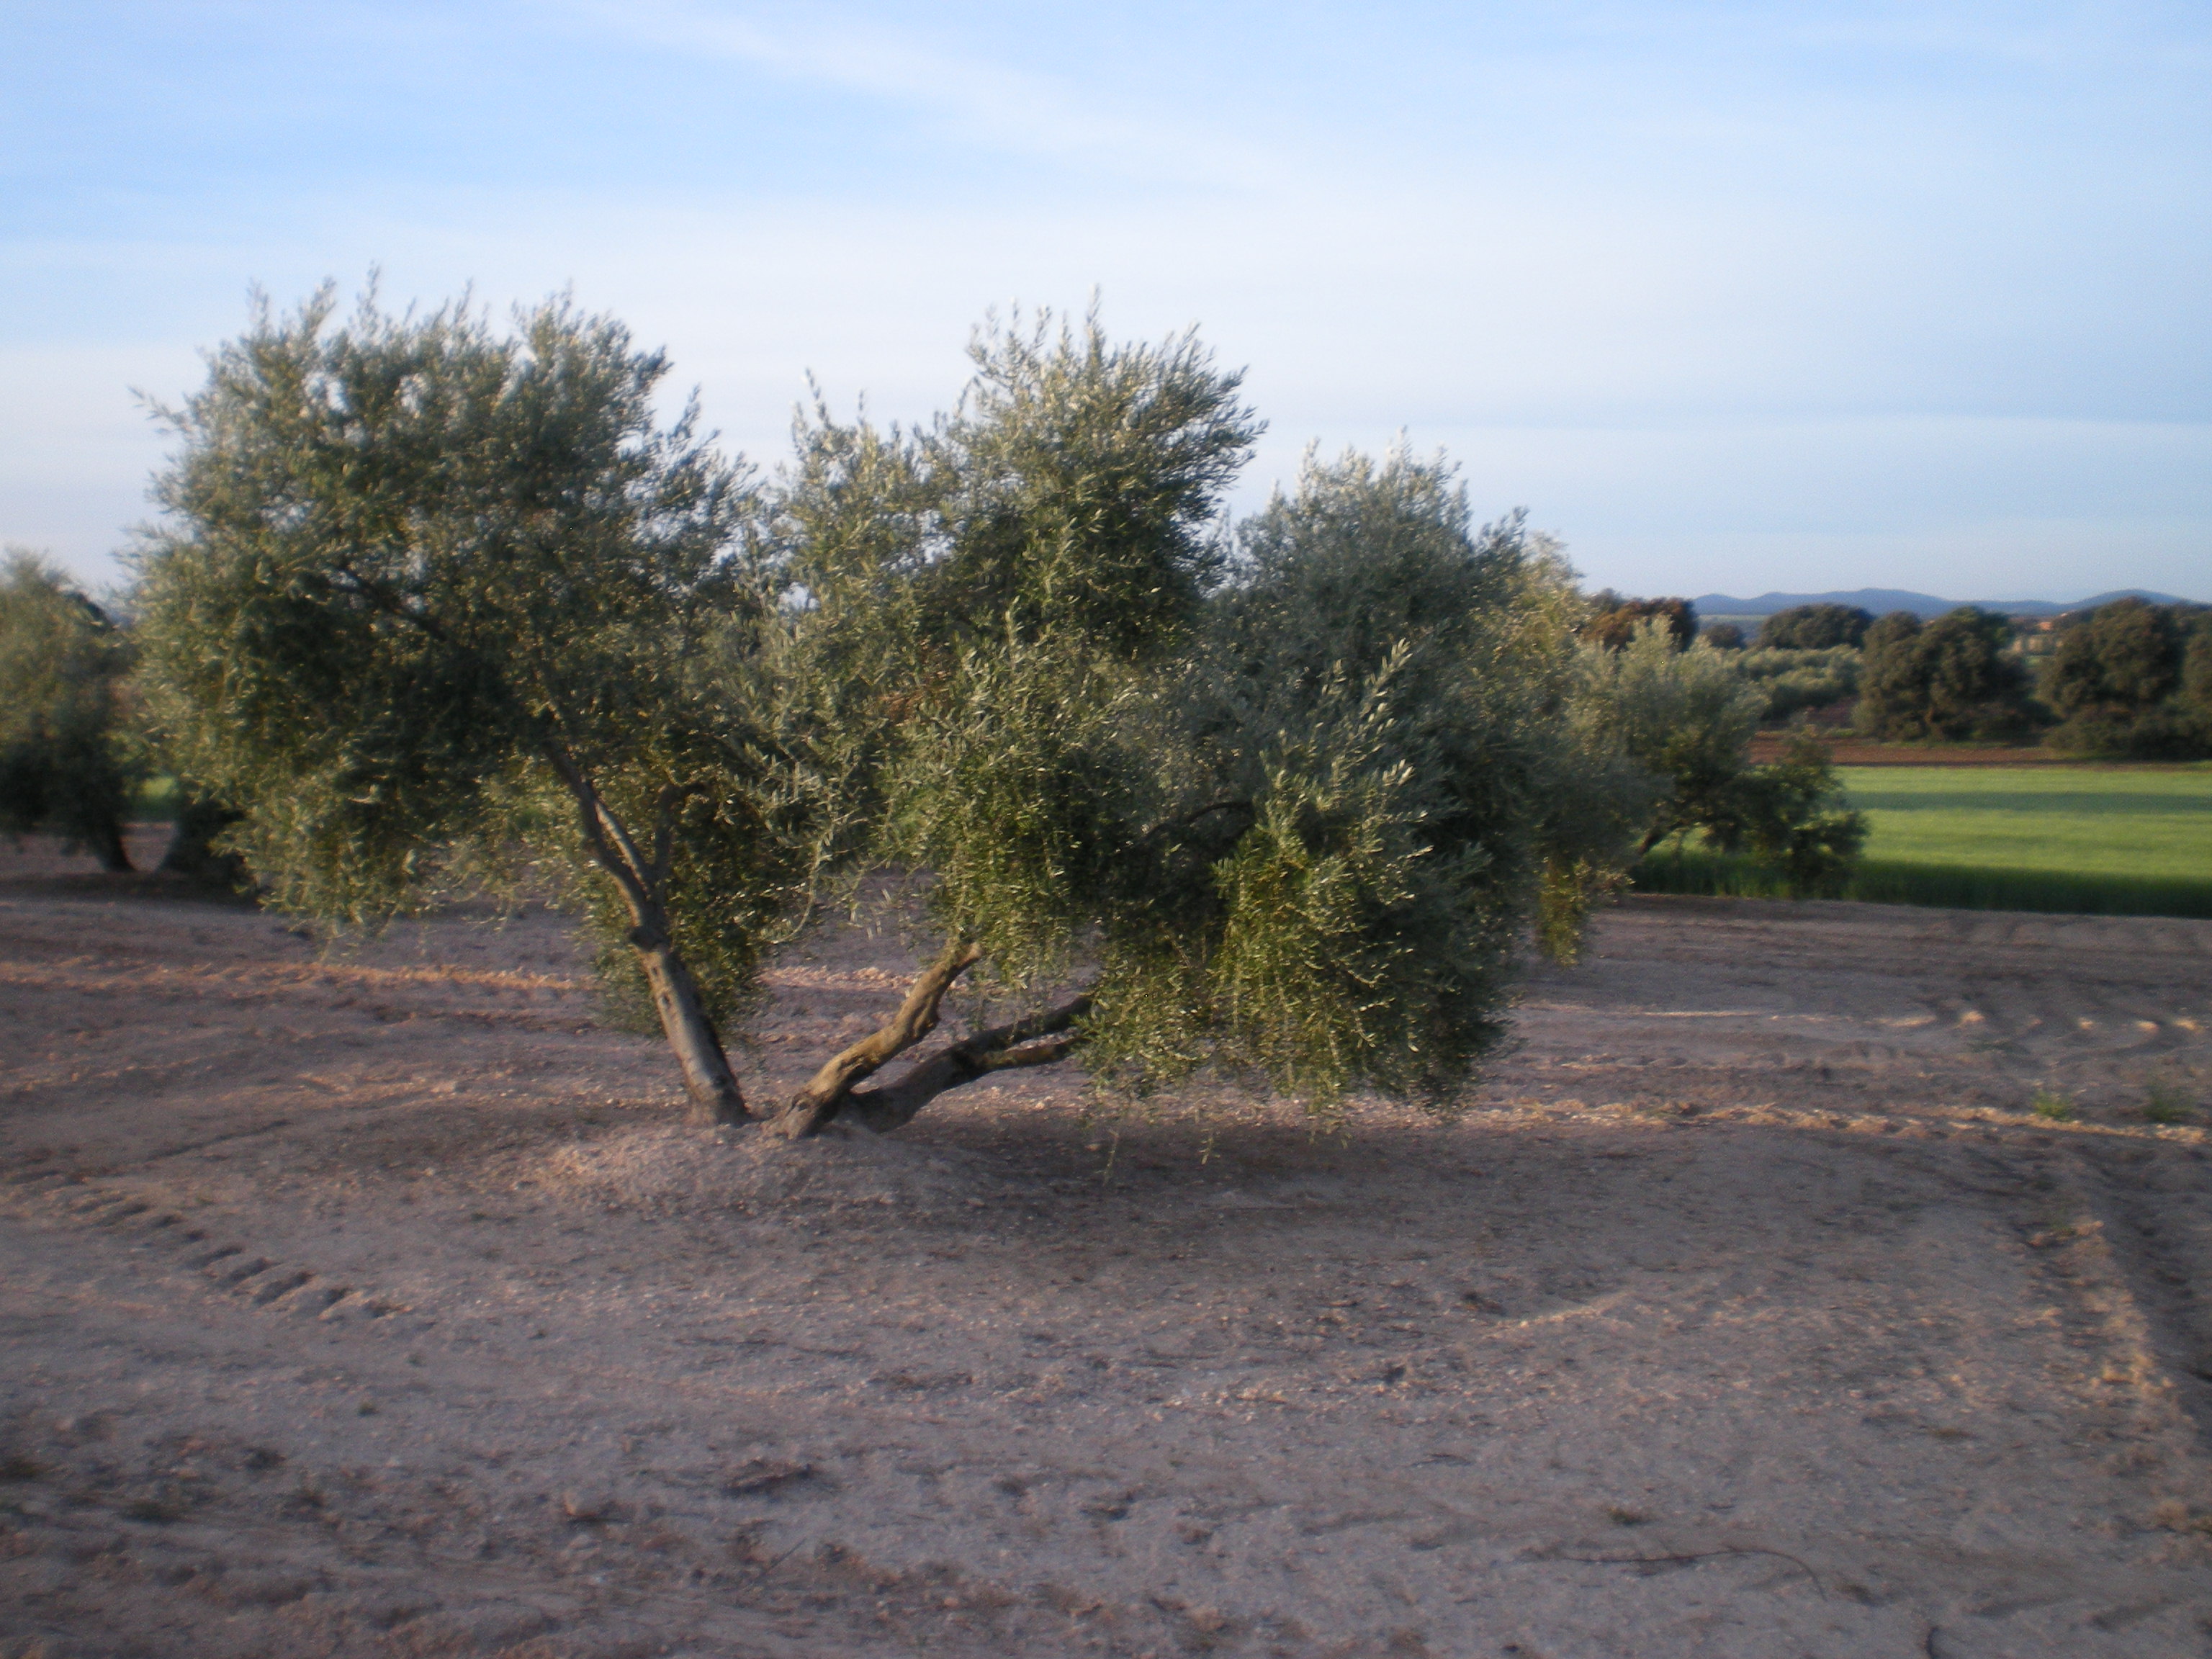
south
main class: Cropland
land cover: Olive groves
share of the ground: 10 - 25 %
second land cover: Other bare soil
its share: > 75 %
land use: Agriculture (excluding fallow land and kitchen gardens)
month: April
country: ES
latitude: 38.5577
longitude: -3.1220
